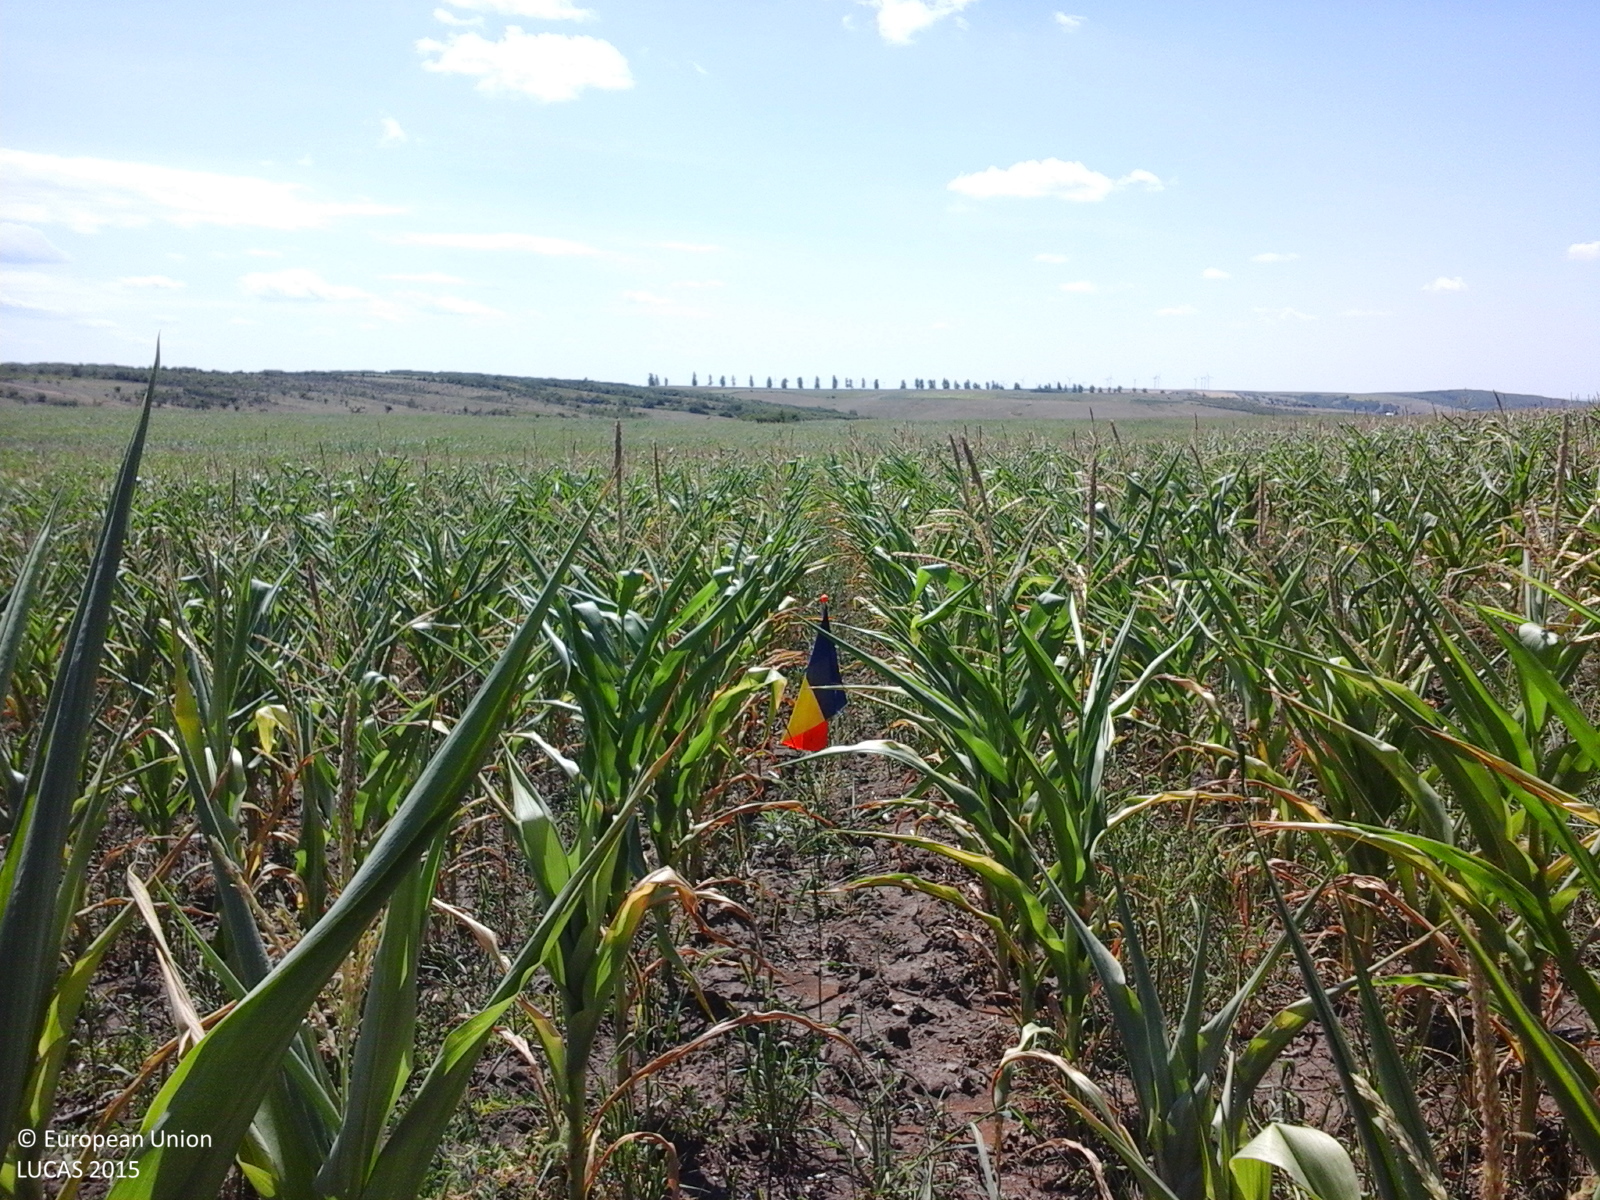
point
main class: Cropland
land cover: Maize
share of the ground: > 75 %
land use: Agriculture (excluding fallow land and kitchen gardens)
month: July
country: RO
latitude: 45.9433
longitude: 27.7204
